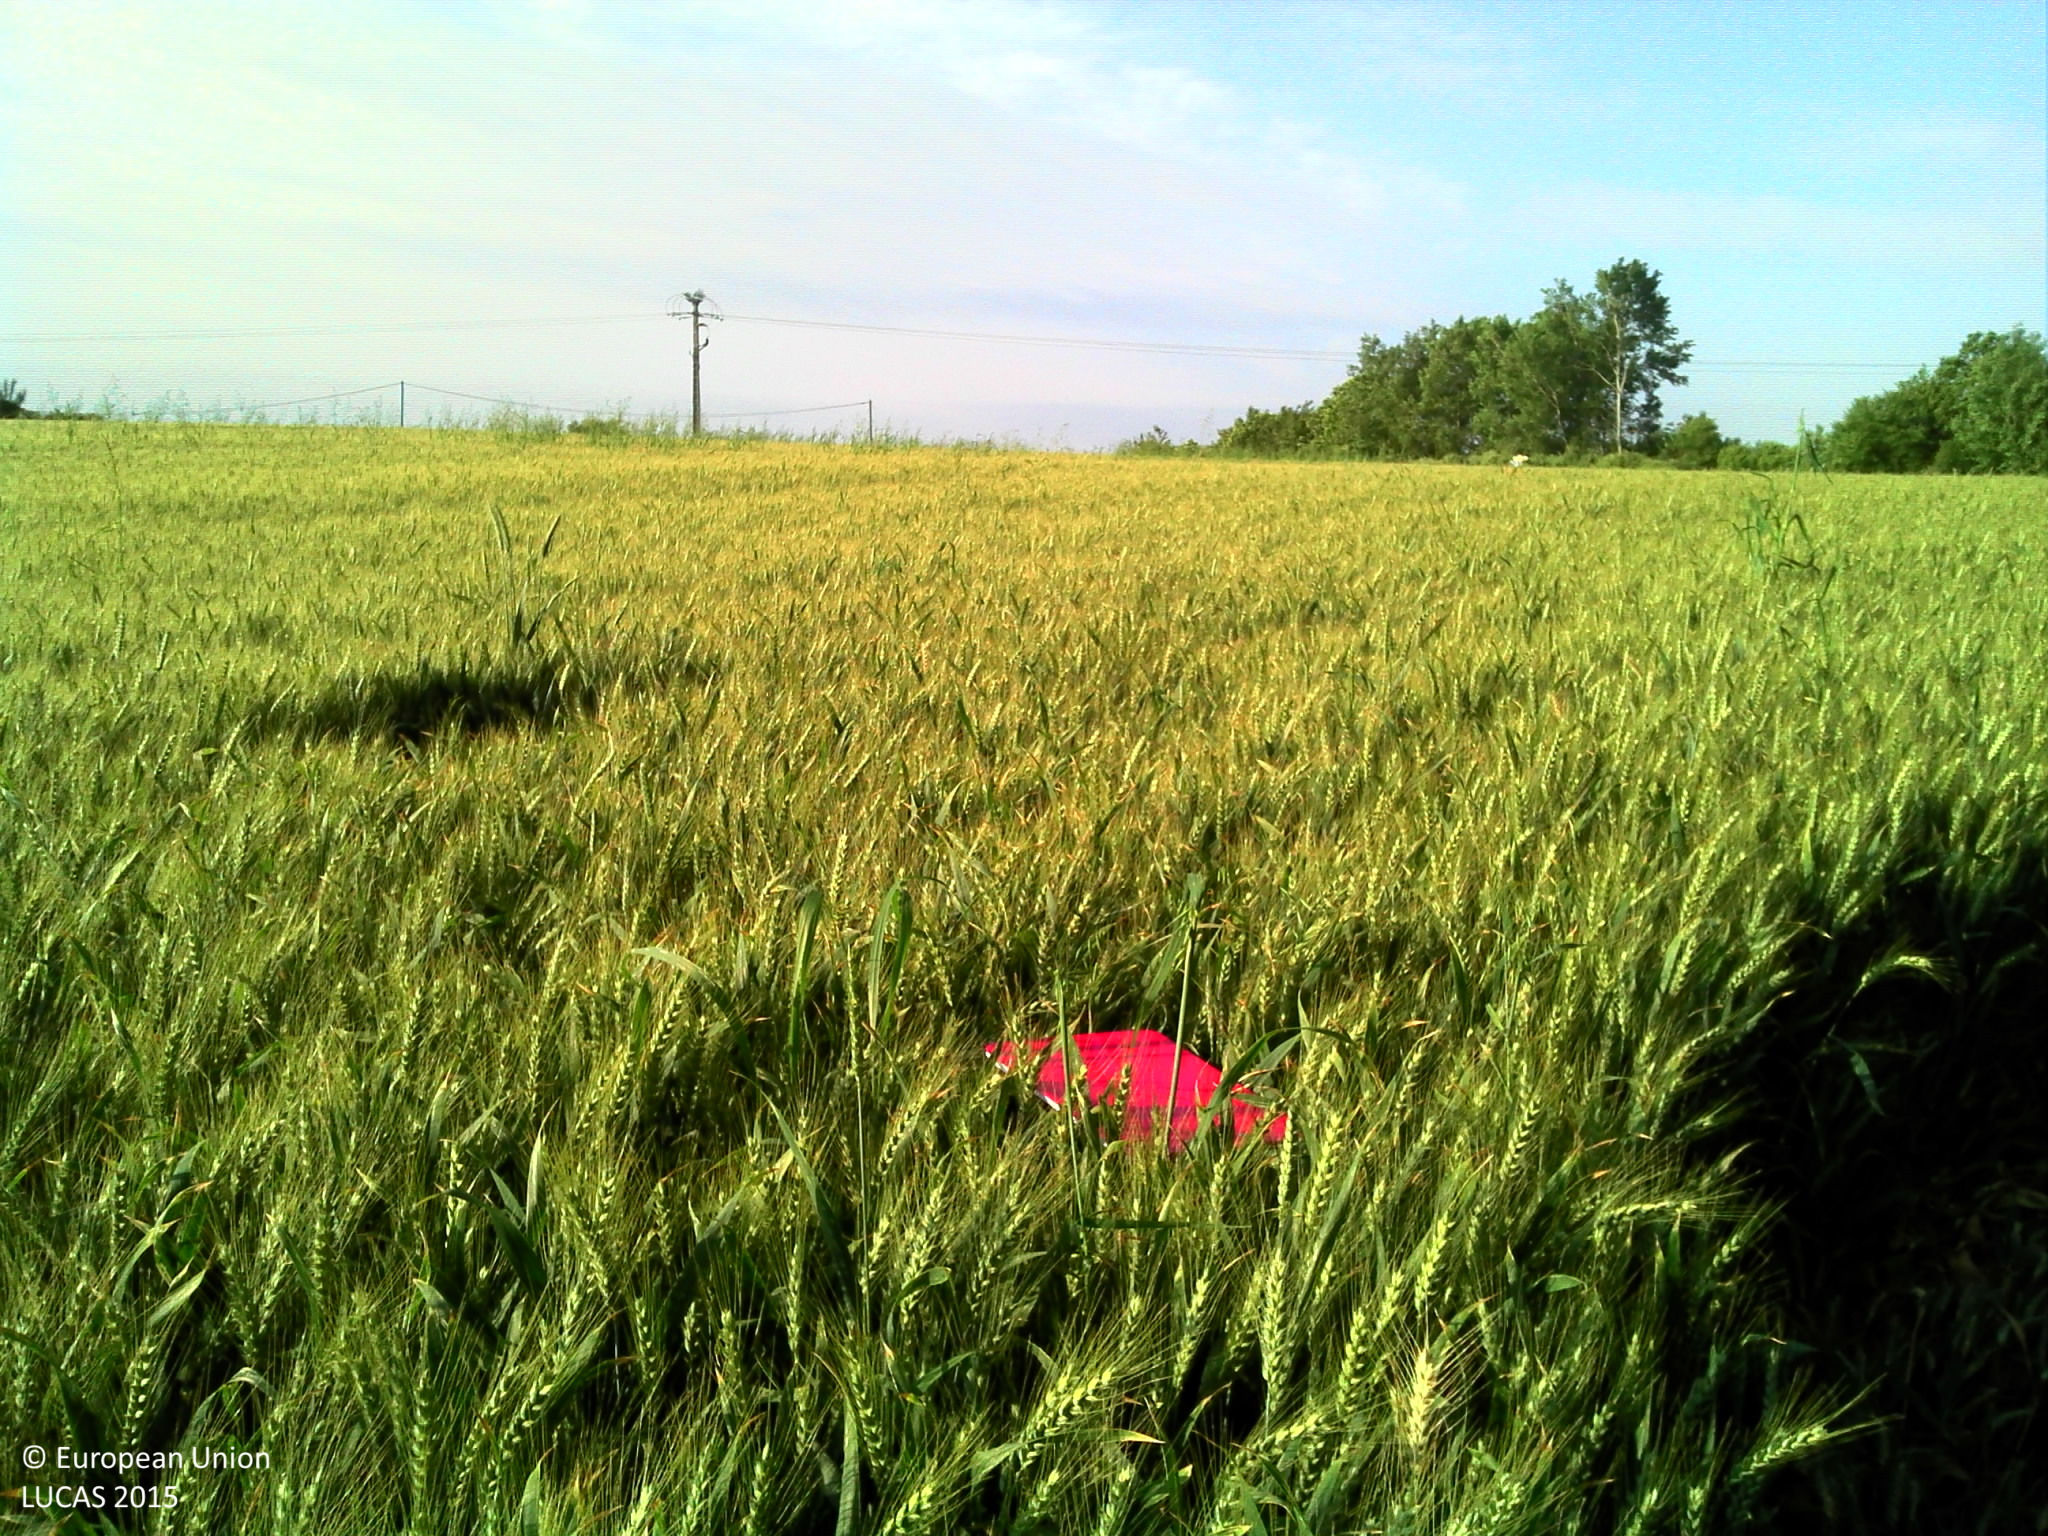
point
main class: Cropland
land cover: Triticale
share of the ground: > 75 %
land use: Agriculture (excluding fallow land and kitchen gardens)
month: June
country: FR
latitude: 48.1612
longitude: -1.7049
